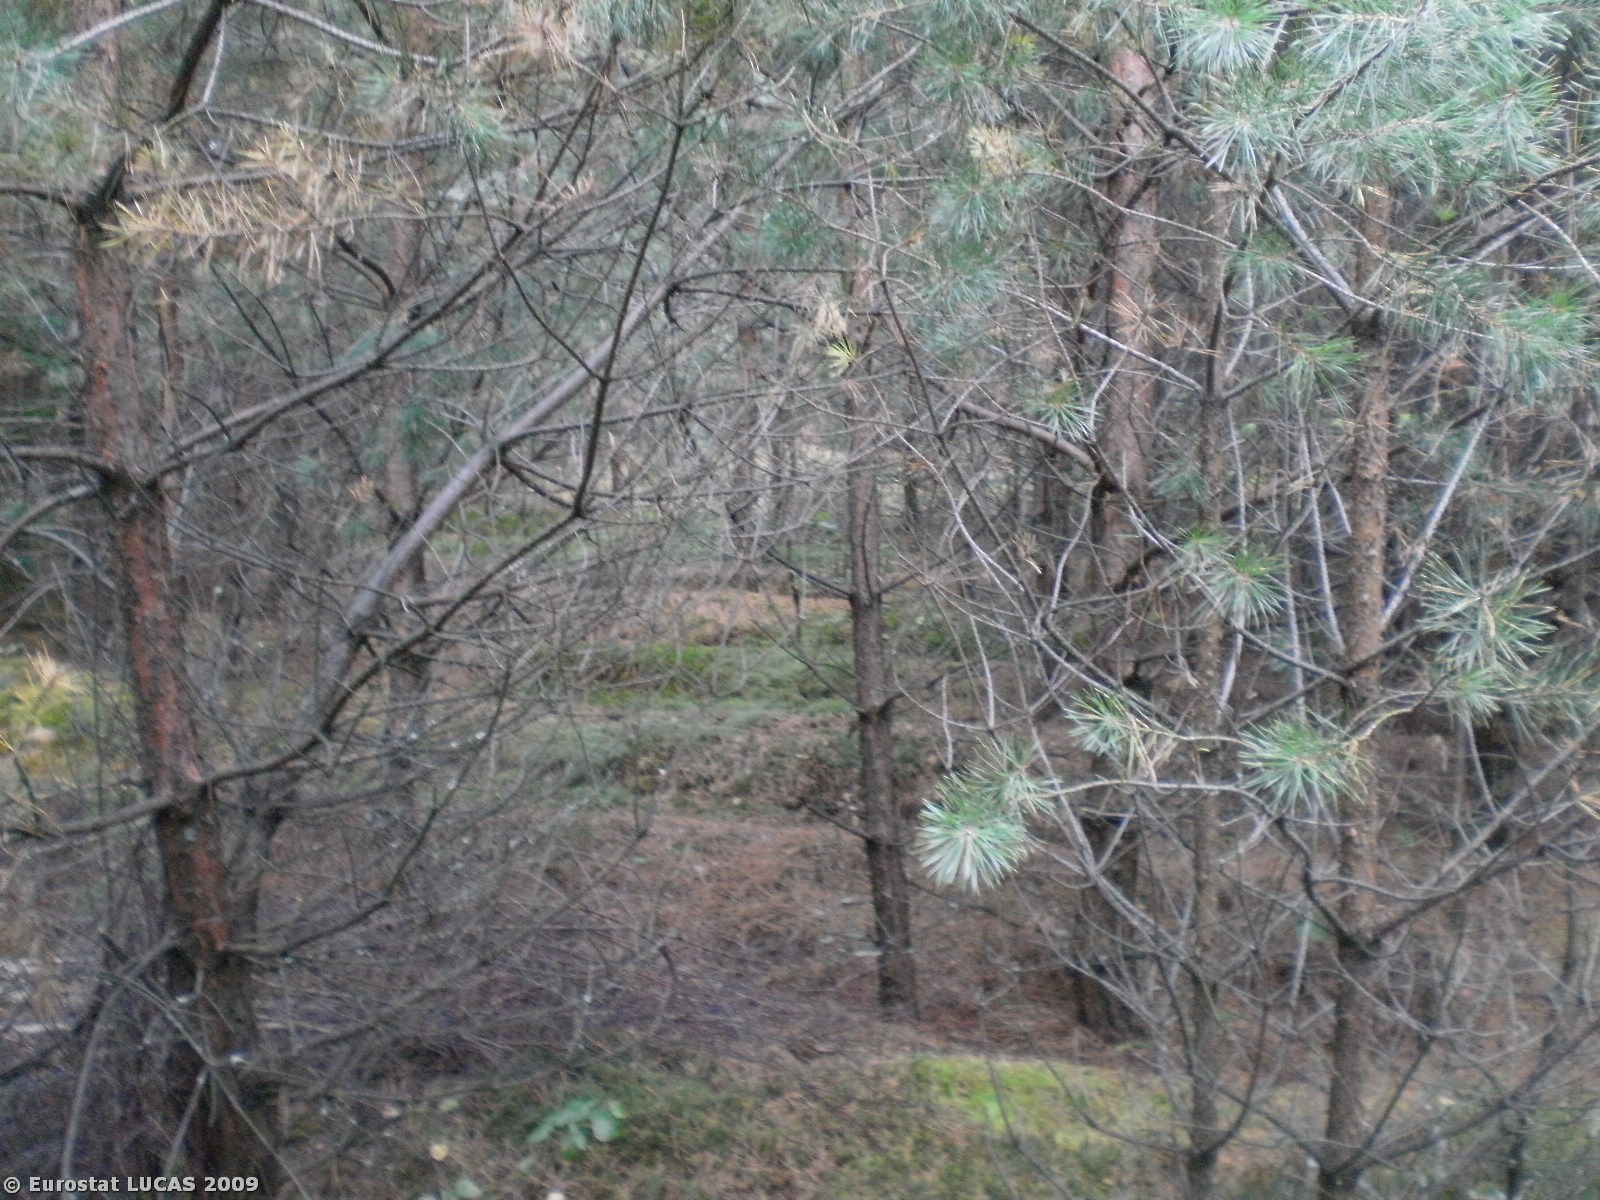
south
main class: Woodland
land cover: Coniferous woodland
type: hemiboreal forest and nemoral coniferous forest and mixed broadleaved-coniferous forest
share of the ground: > 75 %
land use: Forestry
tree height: > 5 m
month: August
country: PL
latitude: 53.0942
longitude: 21.0501
